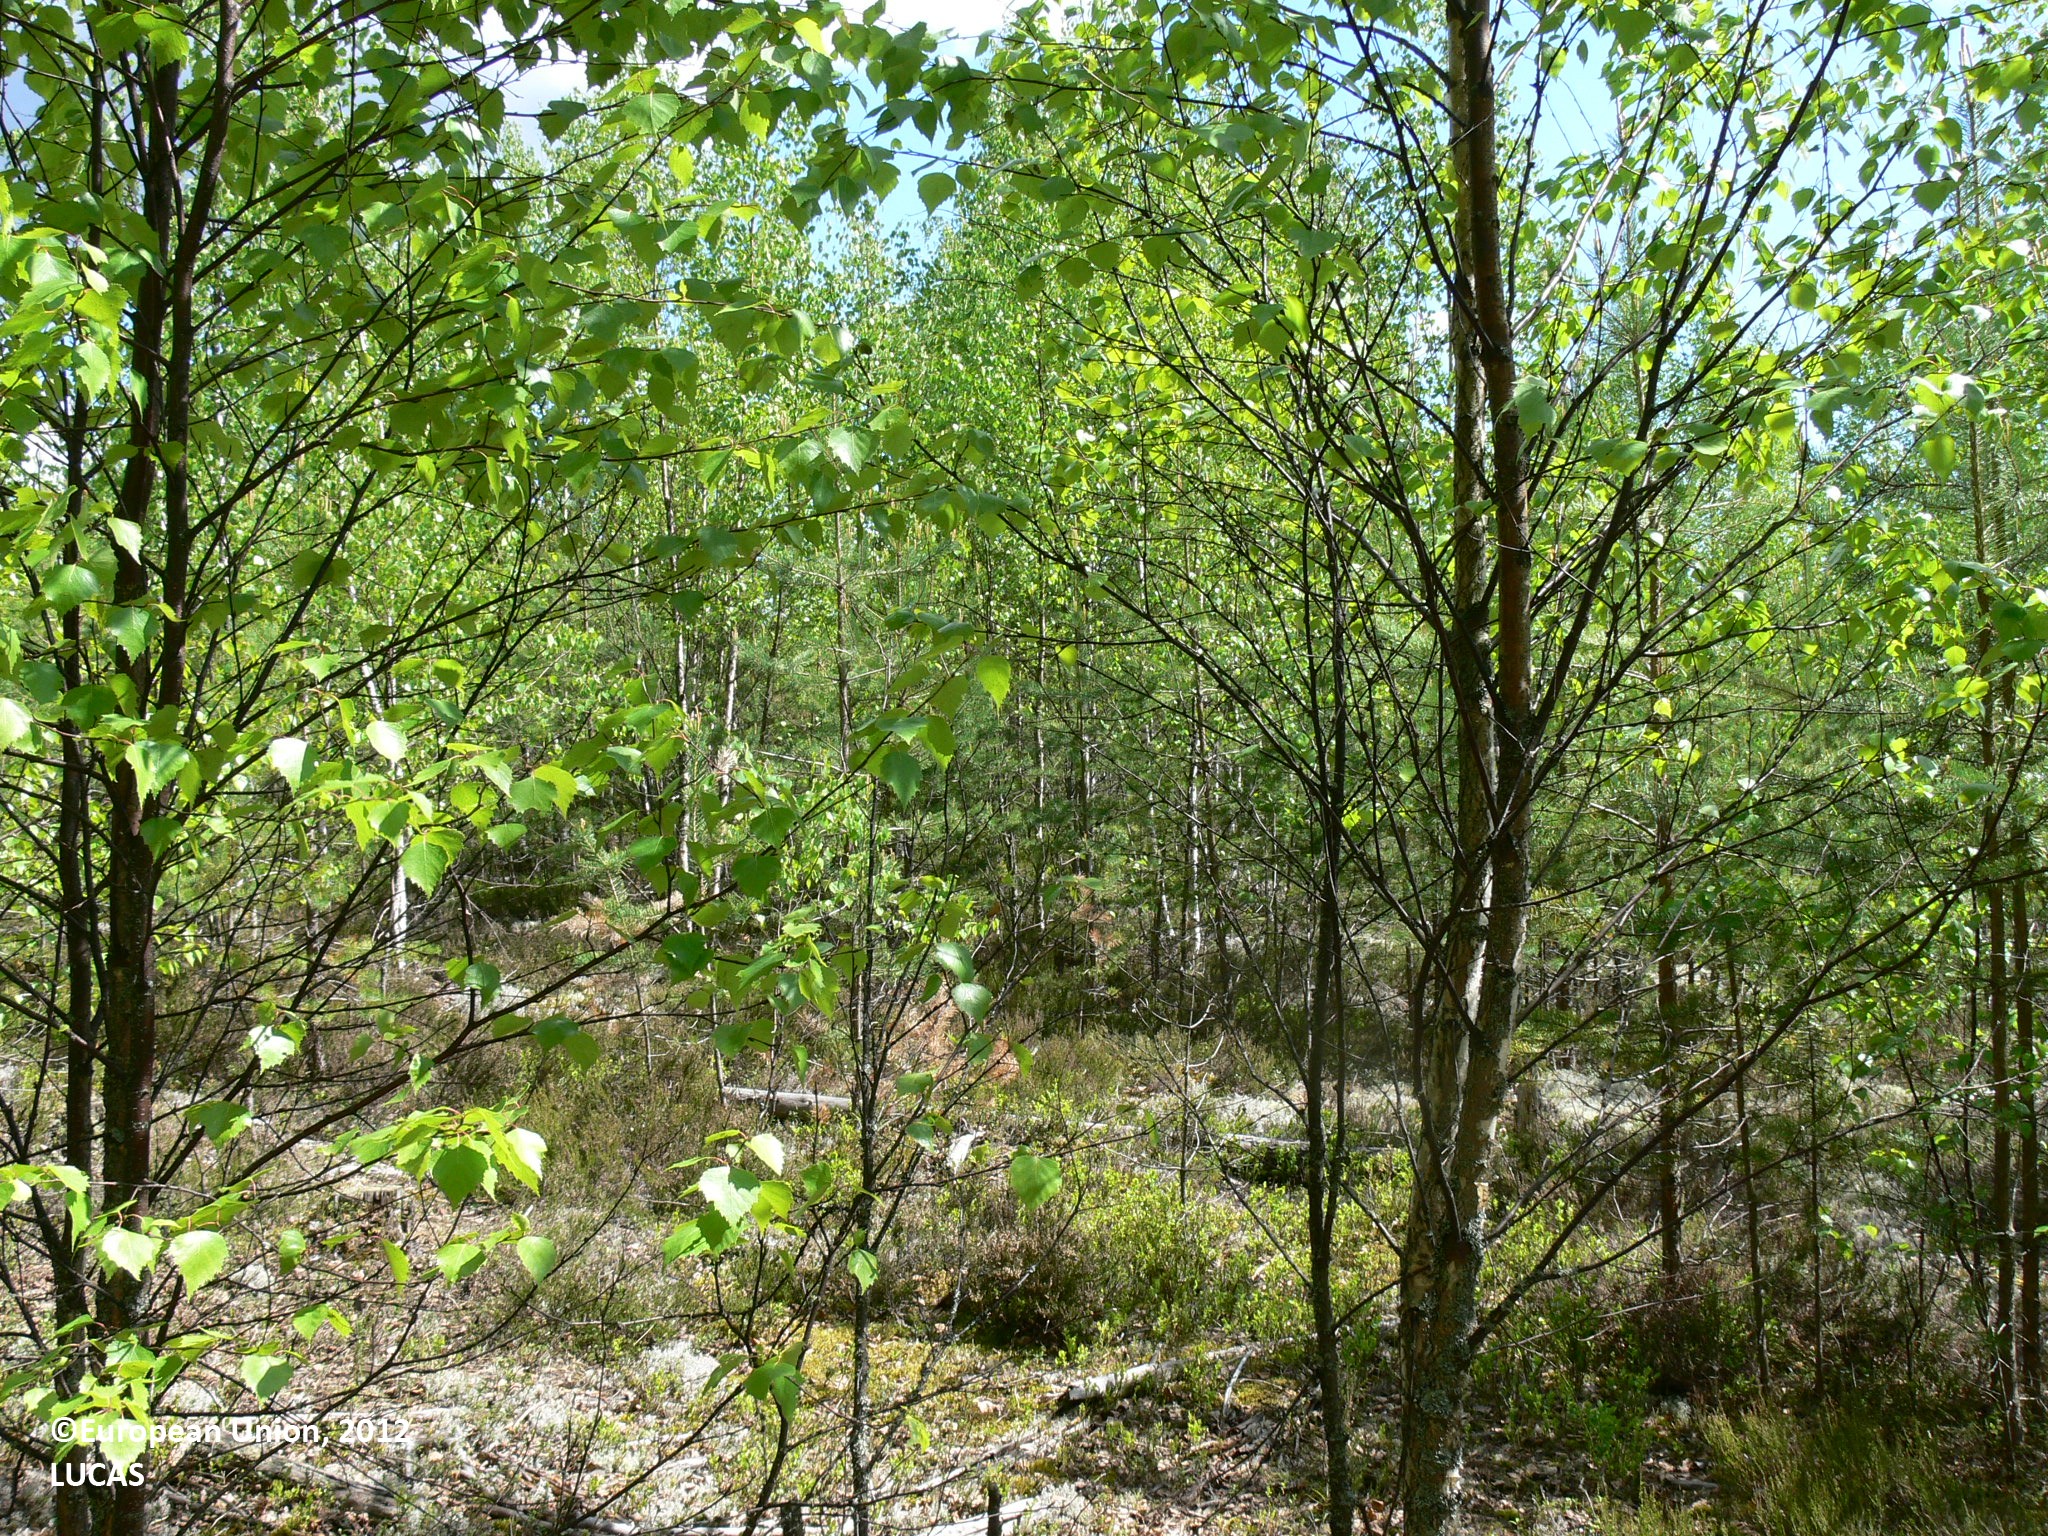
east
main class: Woodland
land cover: Other mixed woodland
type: boreal forest
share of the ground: > 75 %
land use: Forestry
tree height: < 5 m
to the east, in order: Other mixed woodland
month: June
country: FI
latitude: 62.6712
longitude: 29.7122
